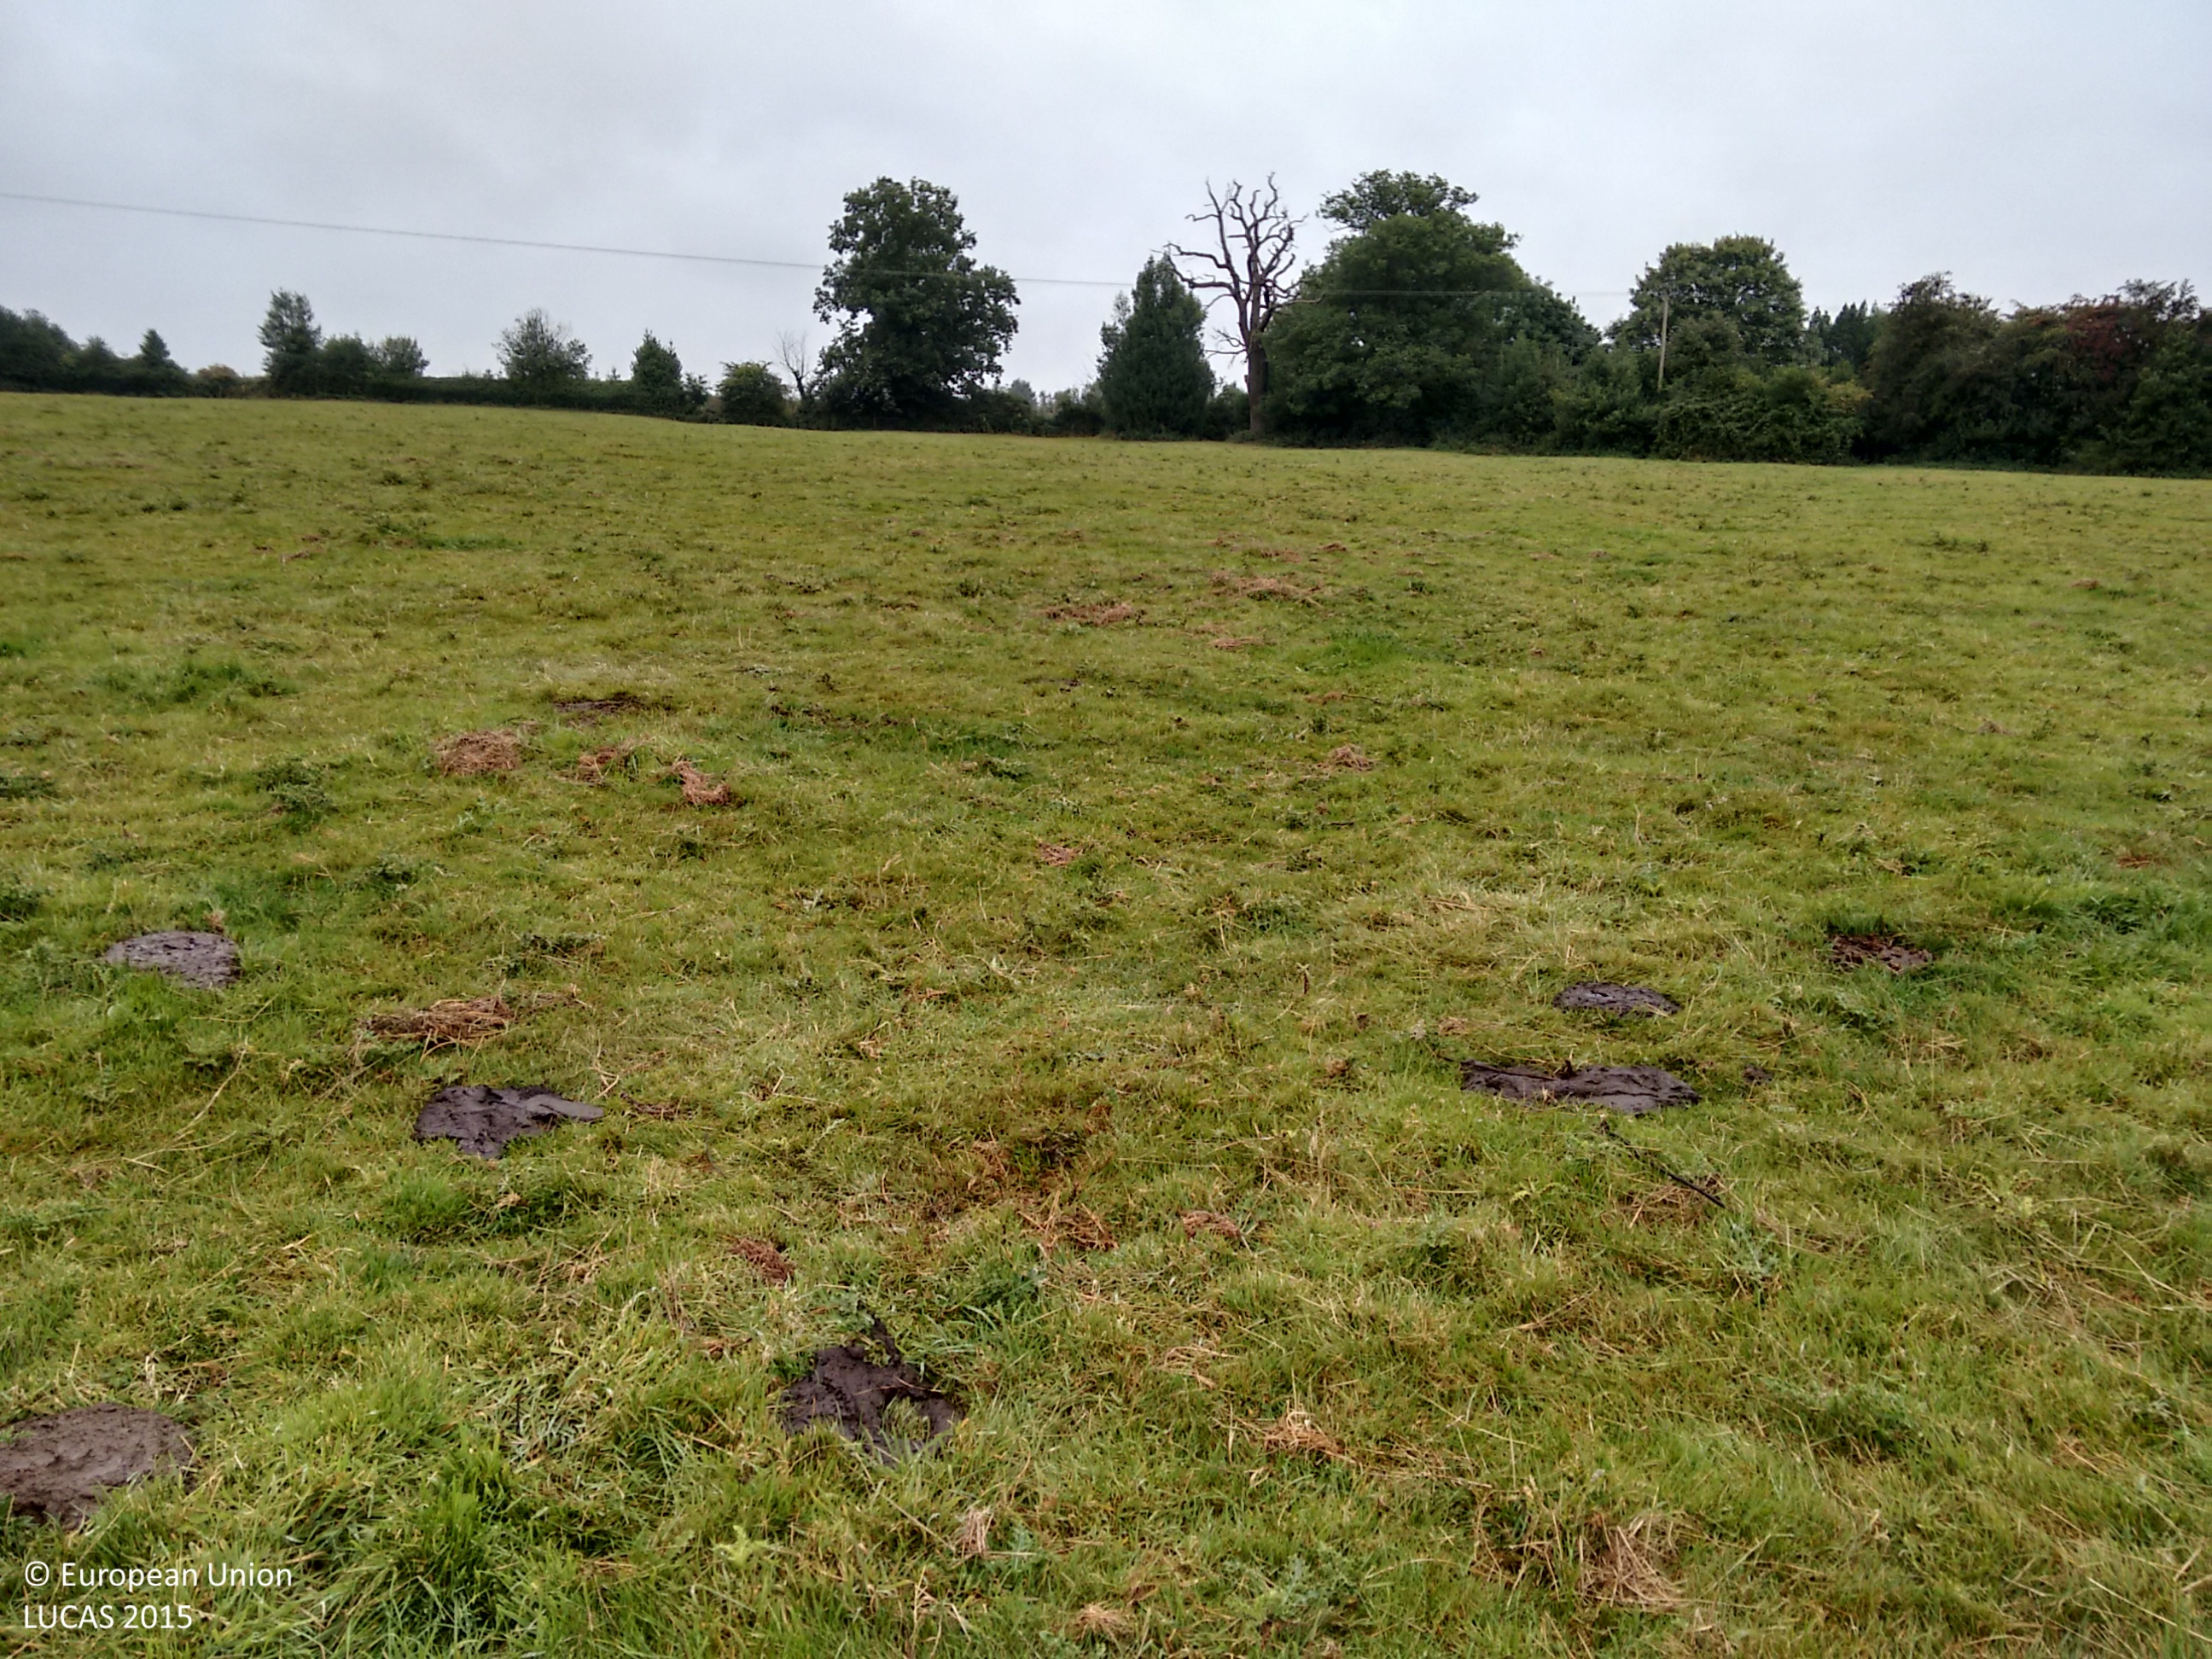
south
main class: Grassland
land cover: Grassland without tree/shrub cover
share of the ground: > 75 %
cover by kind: herbaceous plants 100 %
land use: Agriculture (excluding fallow land and kitchen gardens)
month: August
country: GB
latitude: 52.6273
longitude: -1.3805
